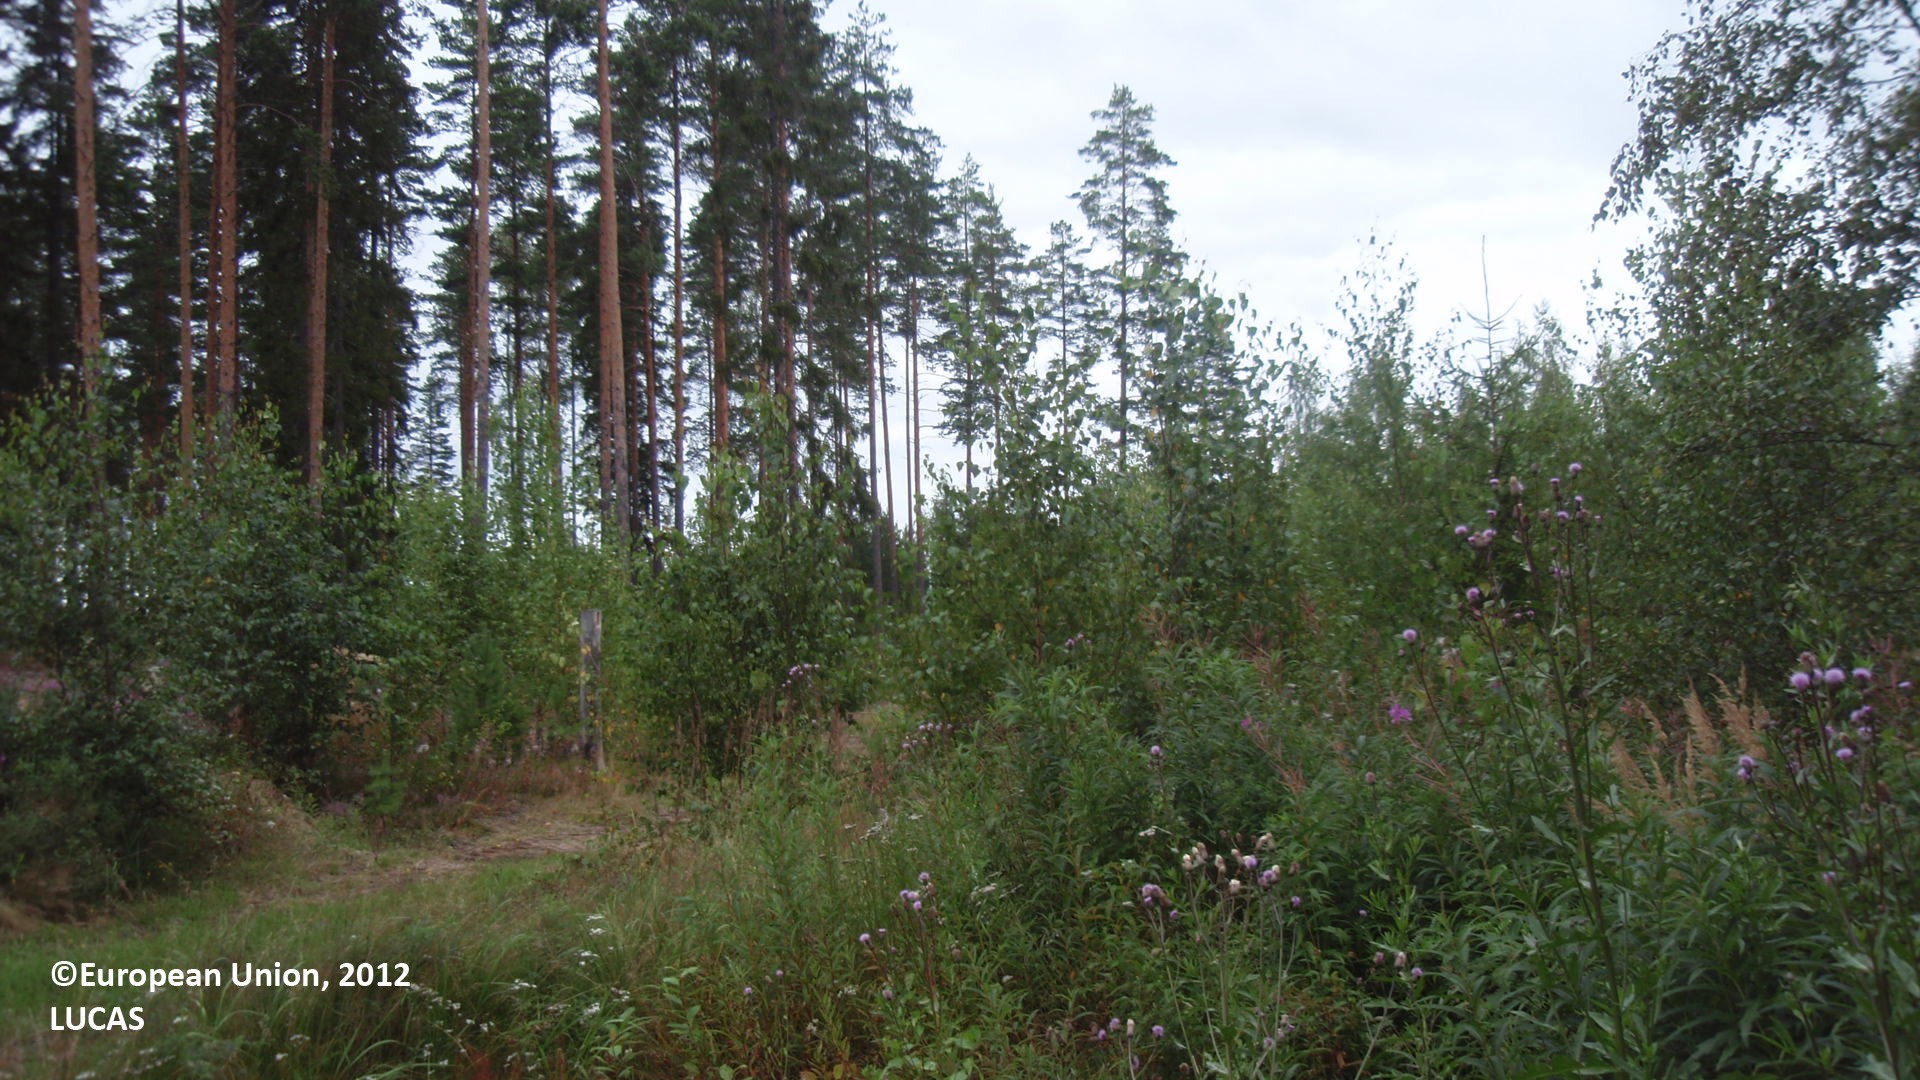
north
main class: Grassland
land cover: Spontaneously vegetated surfaces
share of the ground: > 75 %
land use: Fallow land
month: August
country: FI
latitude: 61.2847
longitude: 27.5905
